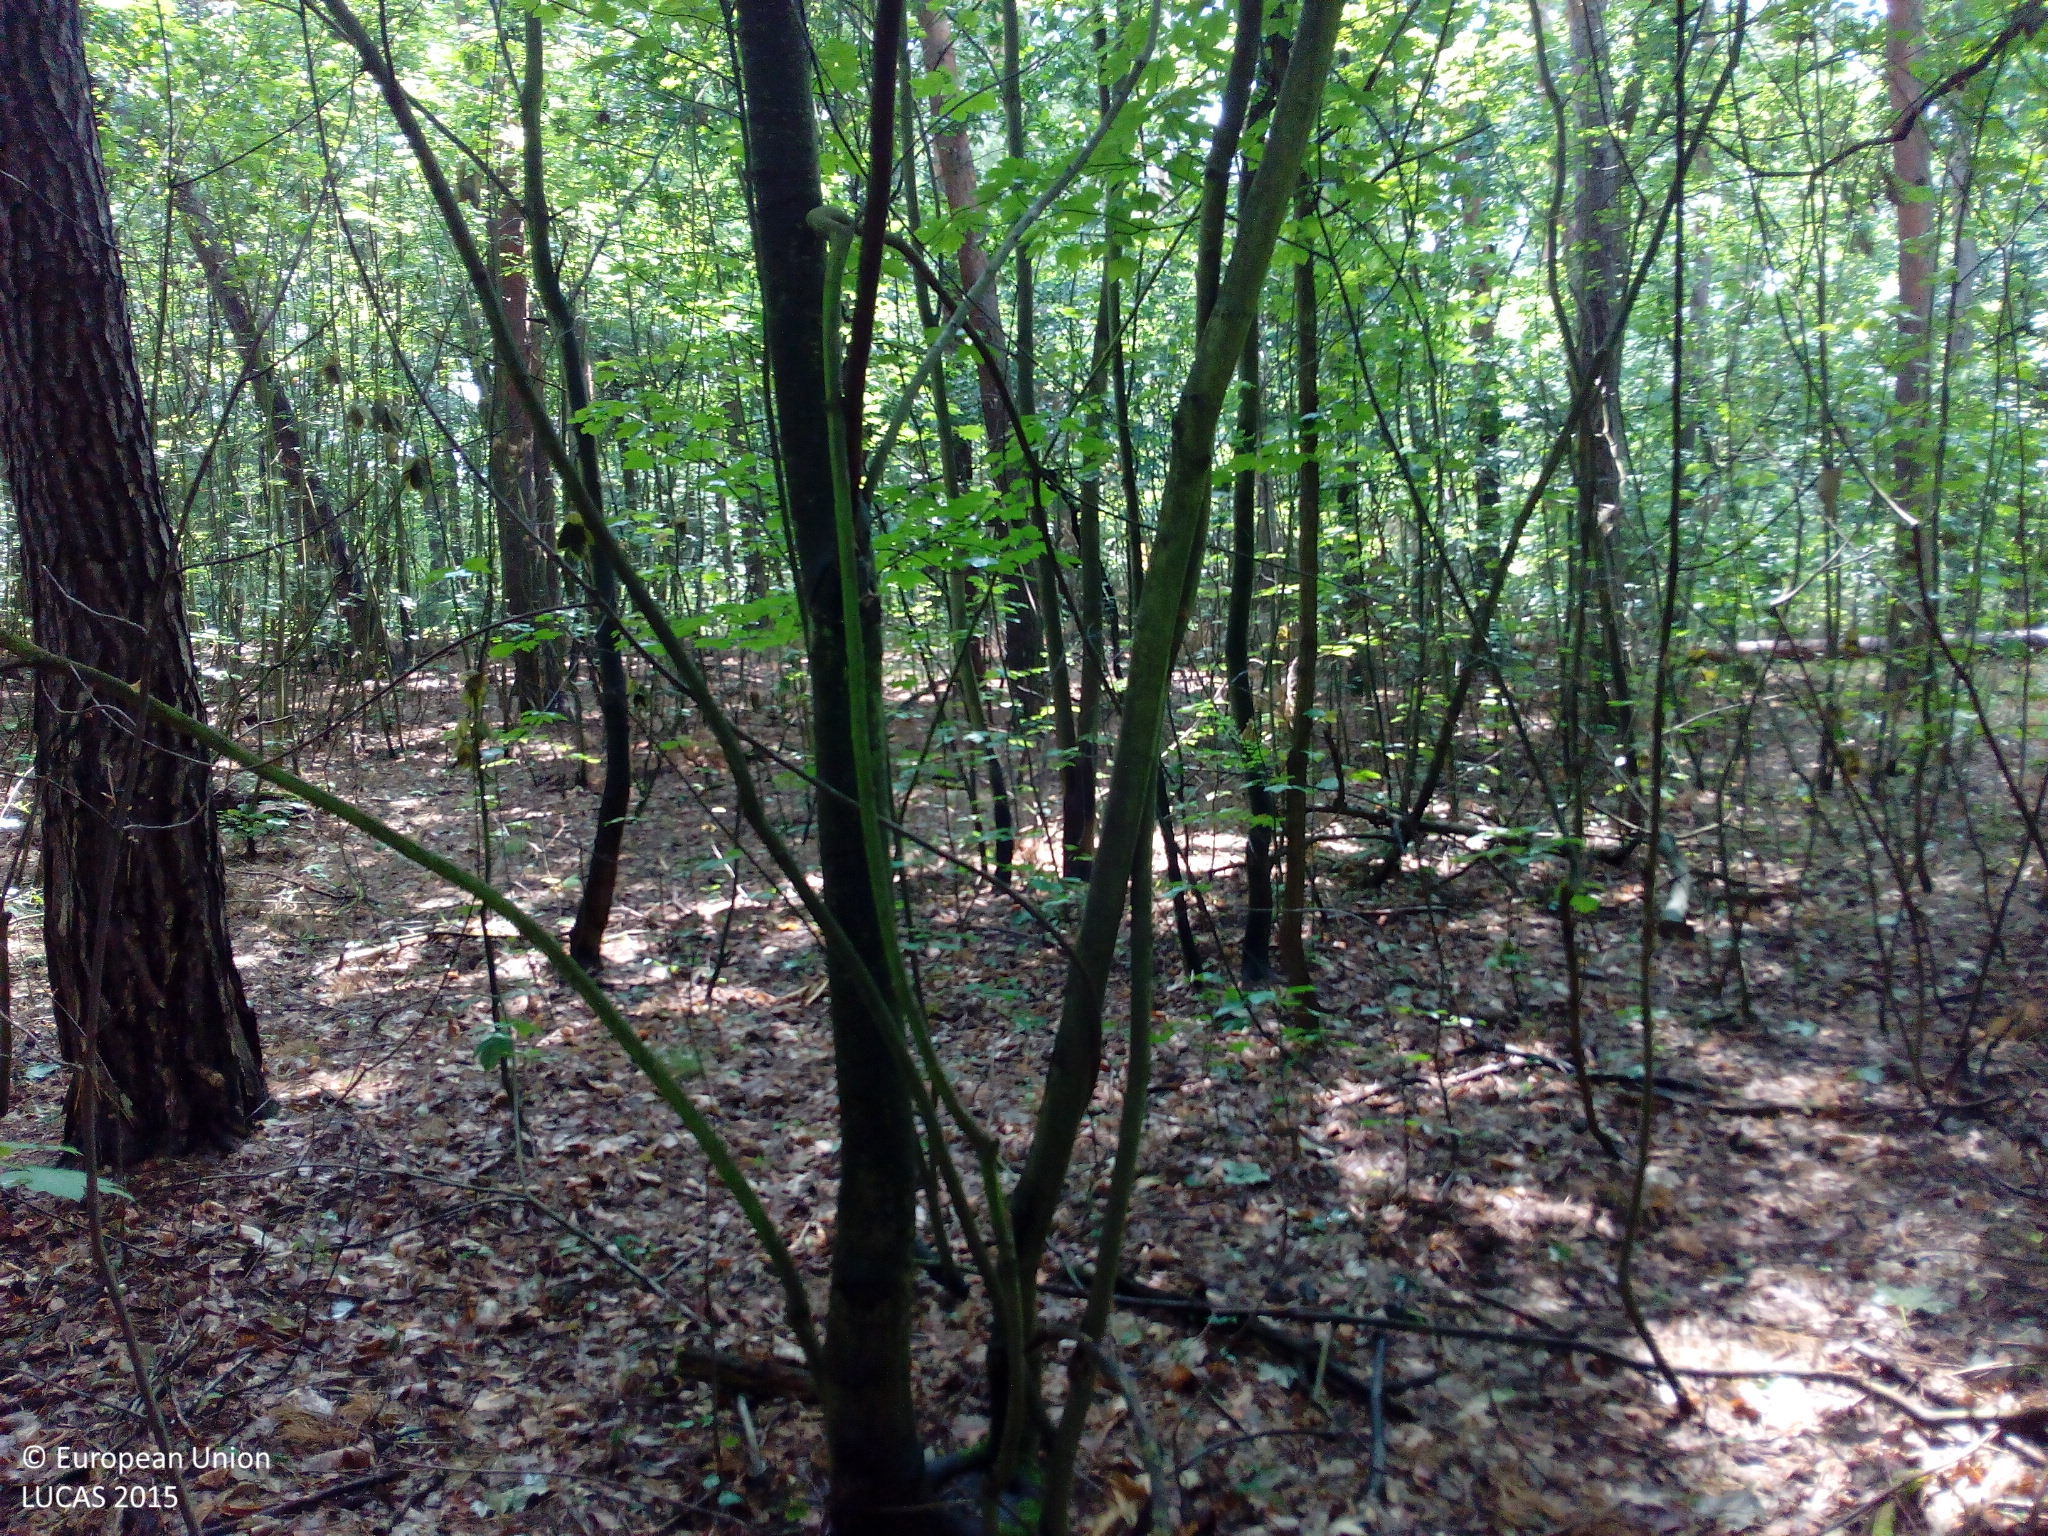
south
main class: Woodland
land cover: Pine dominated mixed woodland
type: hemiboreal forest and nemoral coniferous forest and mixed broadleaved-coniferous forest
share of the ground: > 75 %
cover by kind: coniferous forest trees 70 %, broadleaved forest trees 30 %
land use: Forestry
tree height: > 5 m
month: July
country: DE
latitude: 52.4605
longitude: 13.1937
